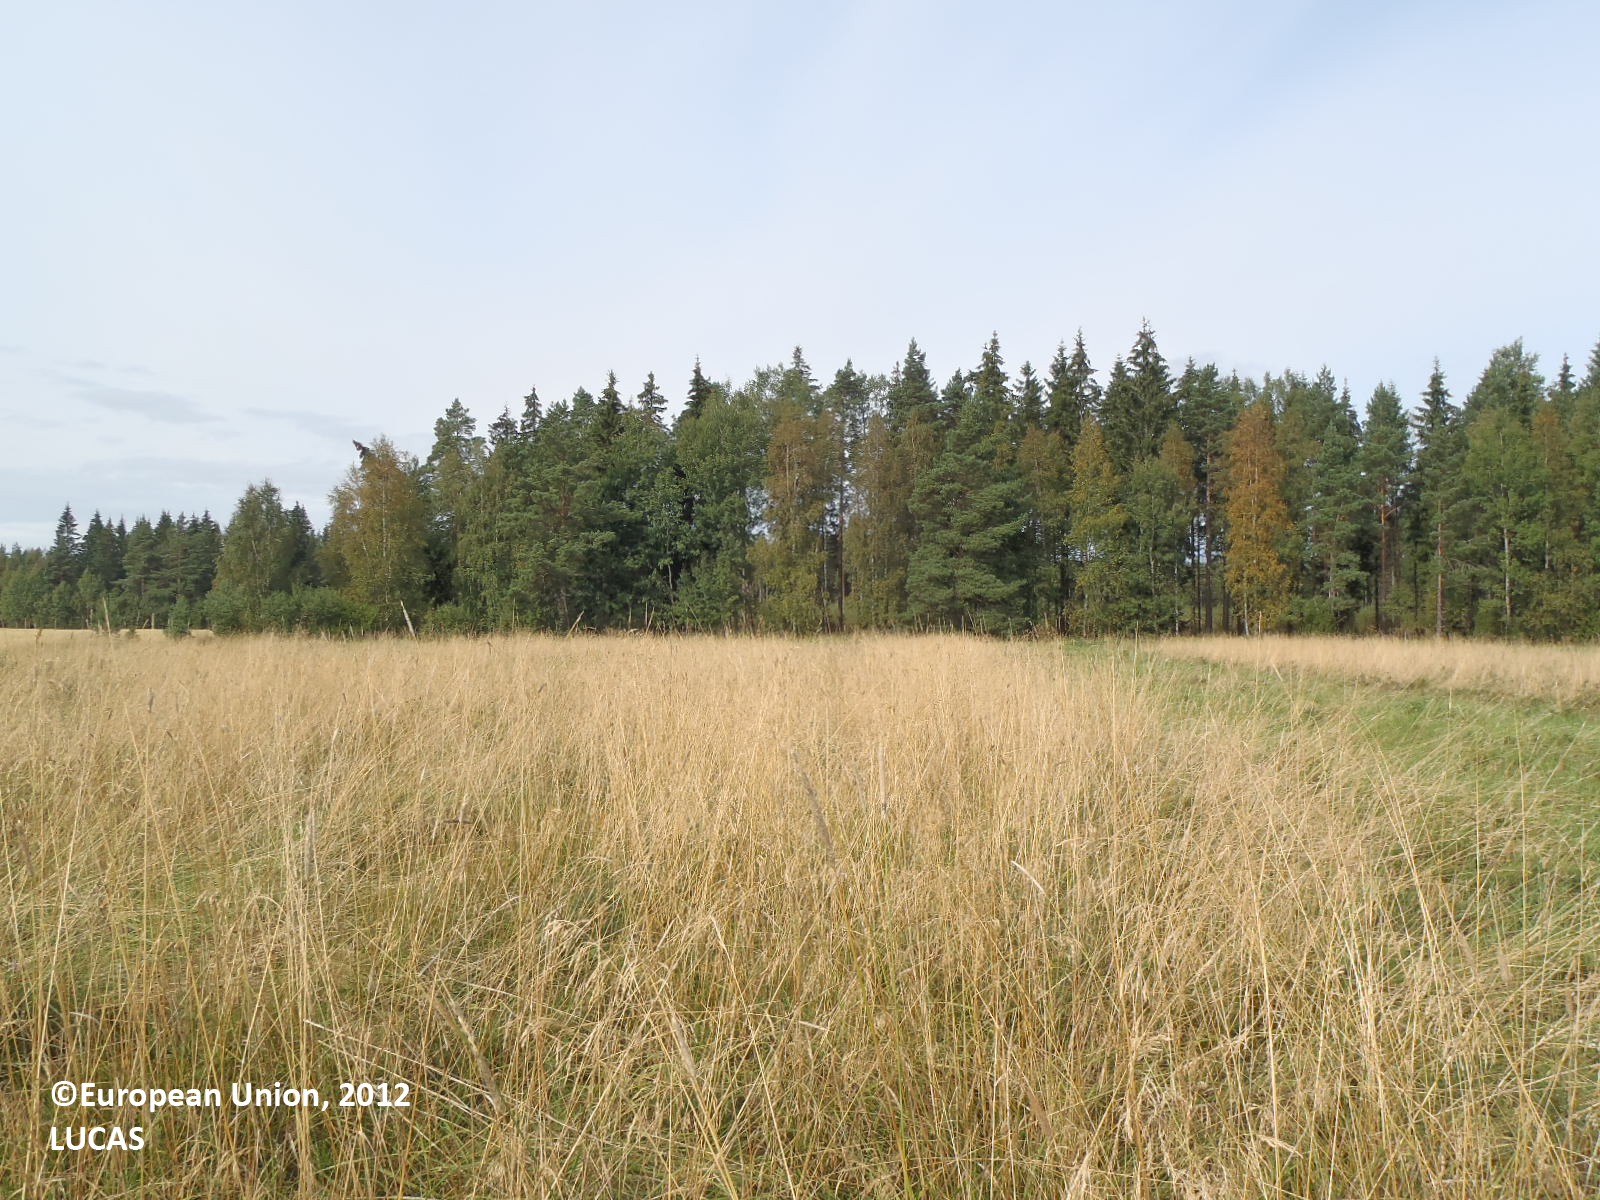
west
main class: Cropland
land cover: Temporary grasslands
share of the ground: > 75 %
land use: Agriculture (excluding fallow land and kitchen gardens)
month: August
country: FI
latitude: 60.7134
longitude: 22.5496
